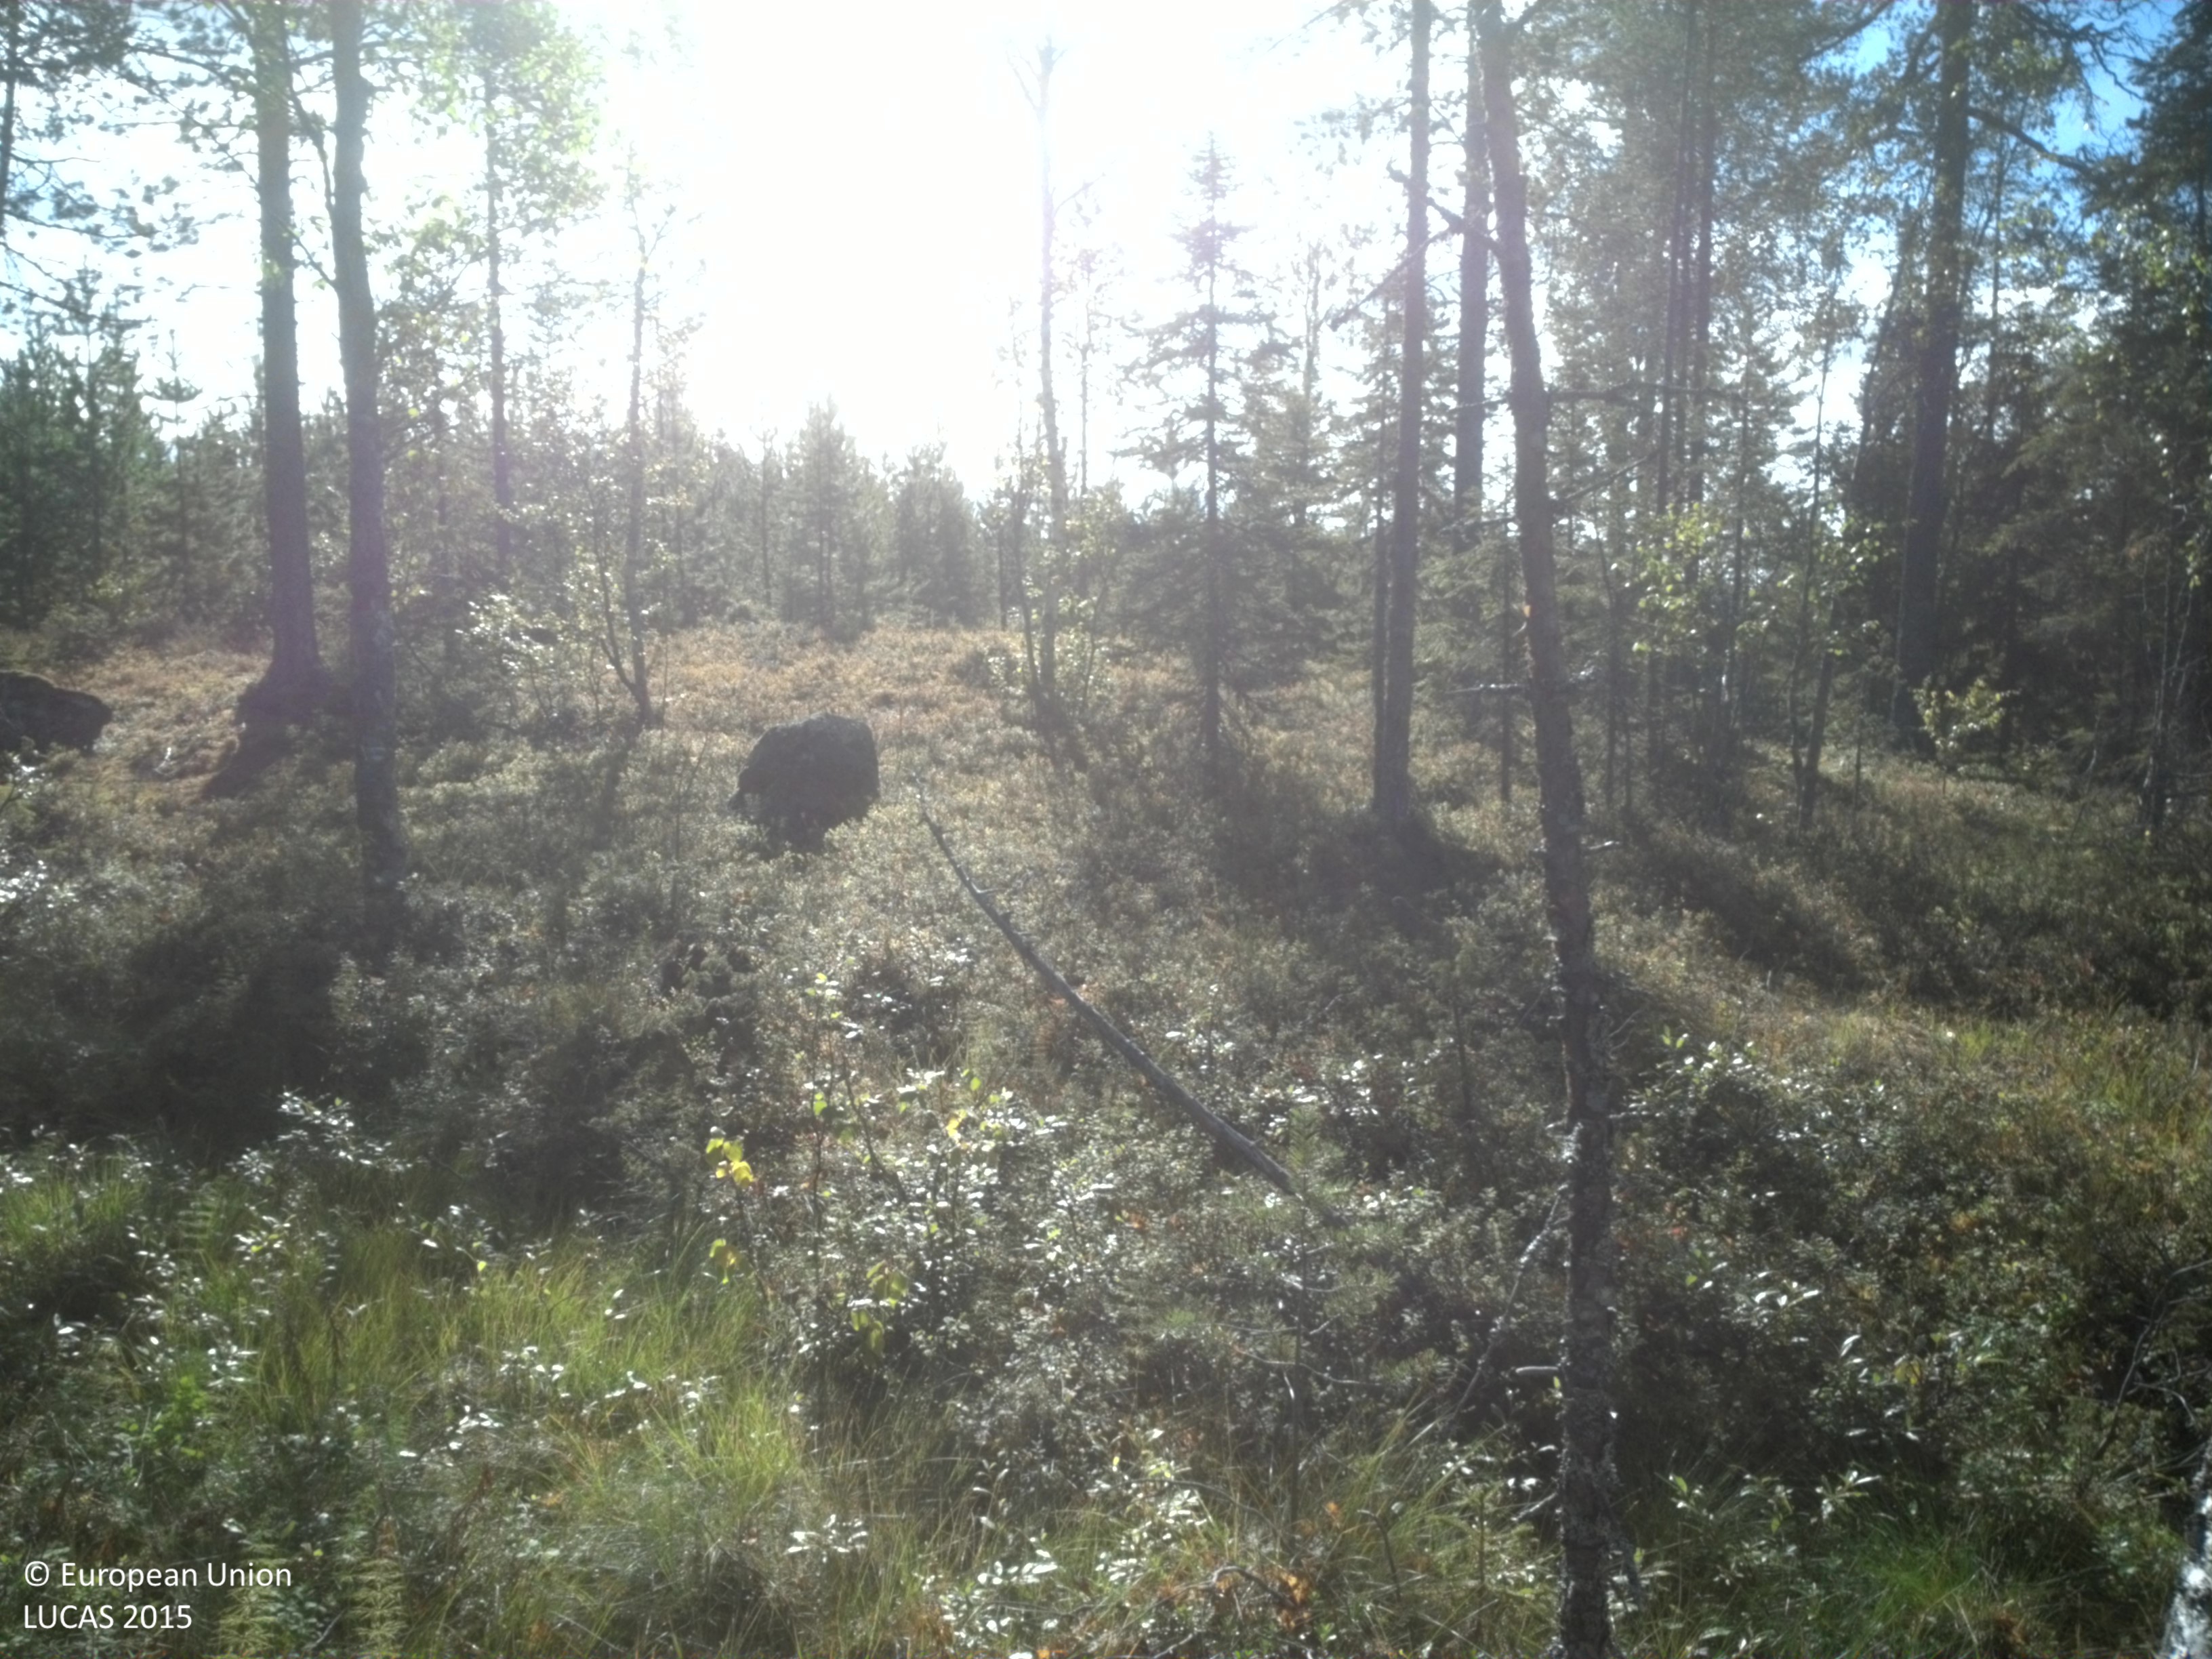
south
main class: Woodland
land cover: Pine dominated coniferous woodland
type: boreal forest
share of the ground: 50 - 75 %
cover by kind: coniferous forest trees 55 %, shrubs 20 %, lichens and mosses 15 %, herbaceous plants 10 %
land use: Forestry
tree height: > 5 m
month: September
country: SE
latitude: 64.5715
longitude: 19.1328
